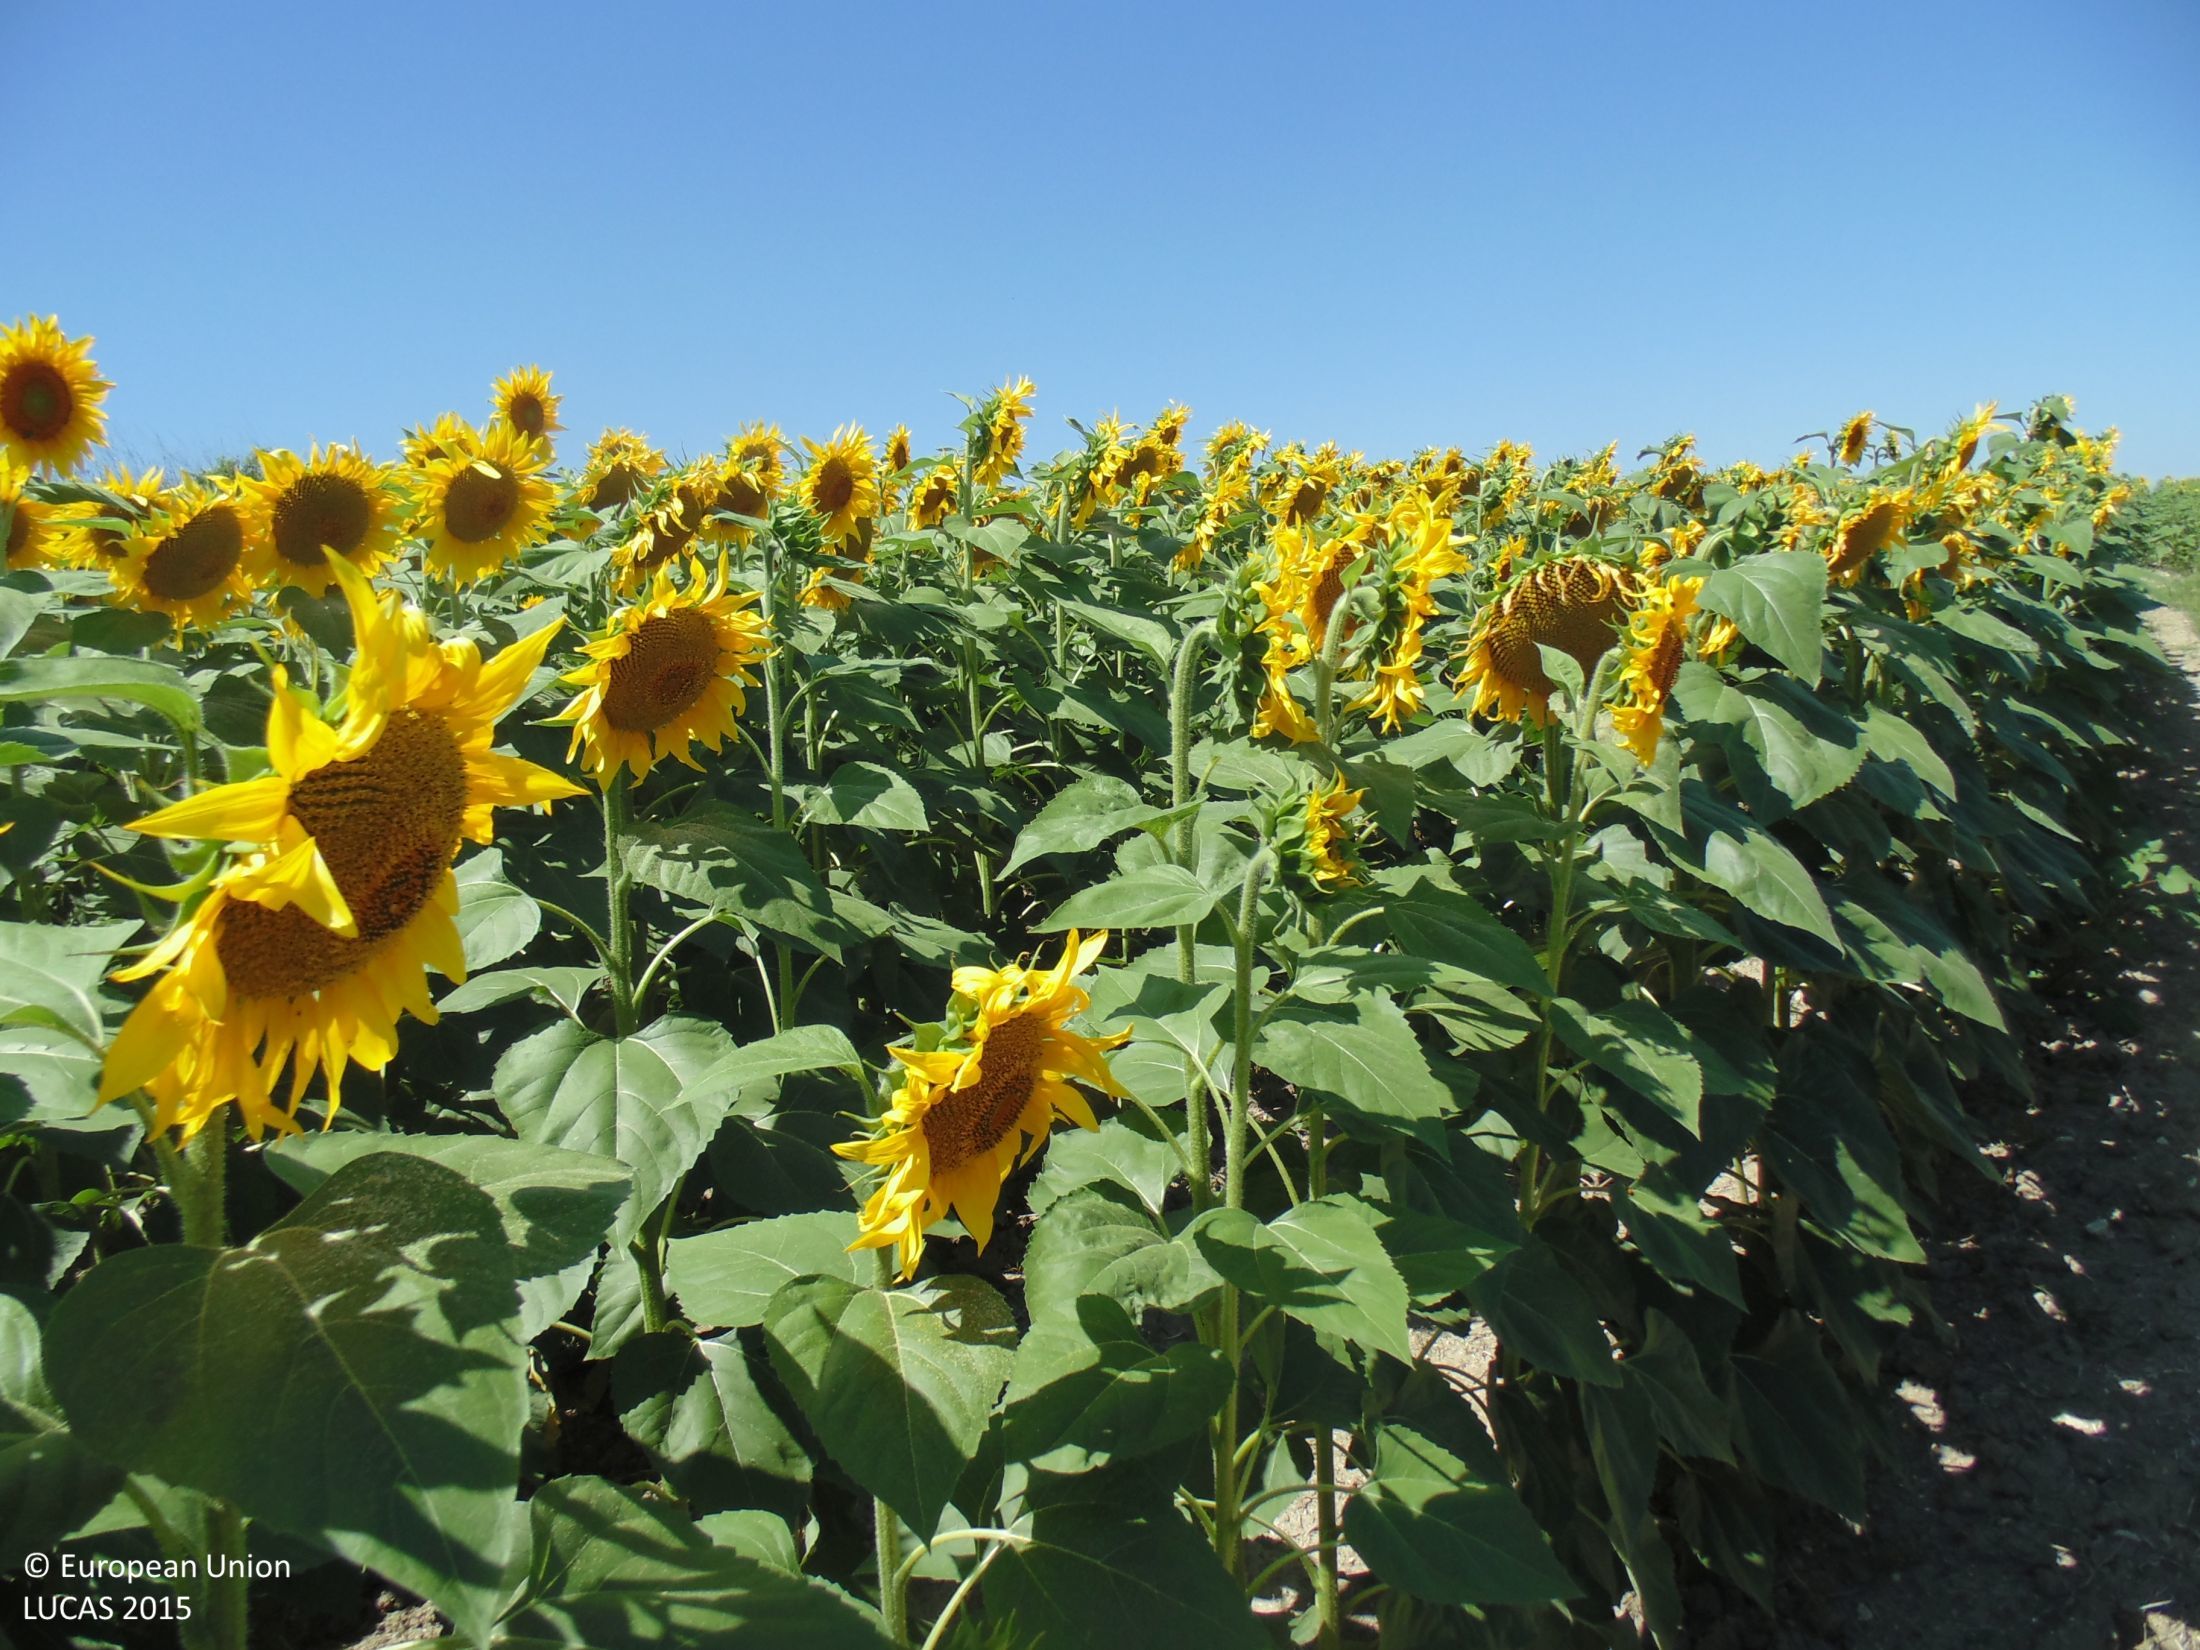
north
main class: Cropland
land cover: Sunflower
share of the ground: > 75 %
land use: Agriculture (excluding fallow land and kitchen gardens)
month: July
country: BG
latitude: 43.3647
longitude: 28.0252
